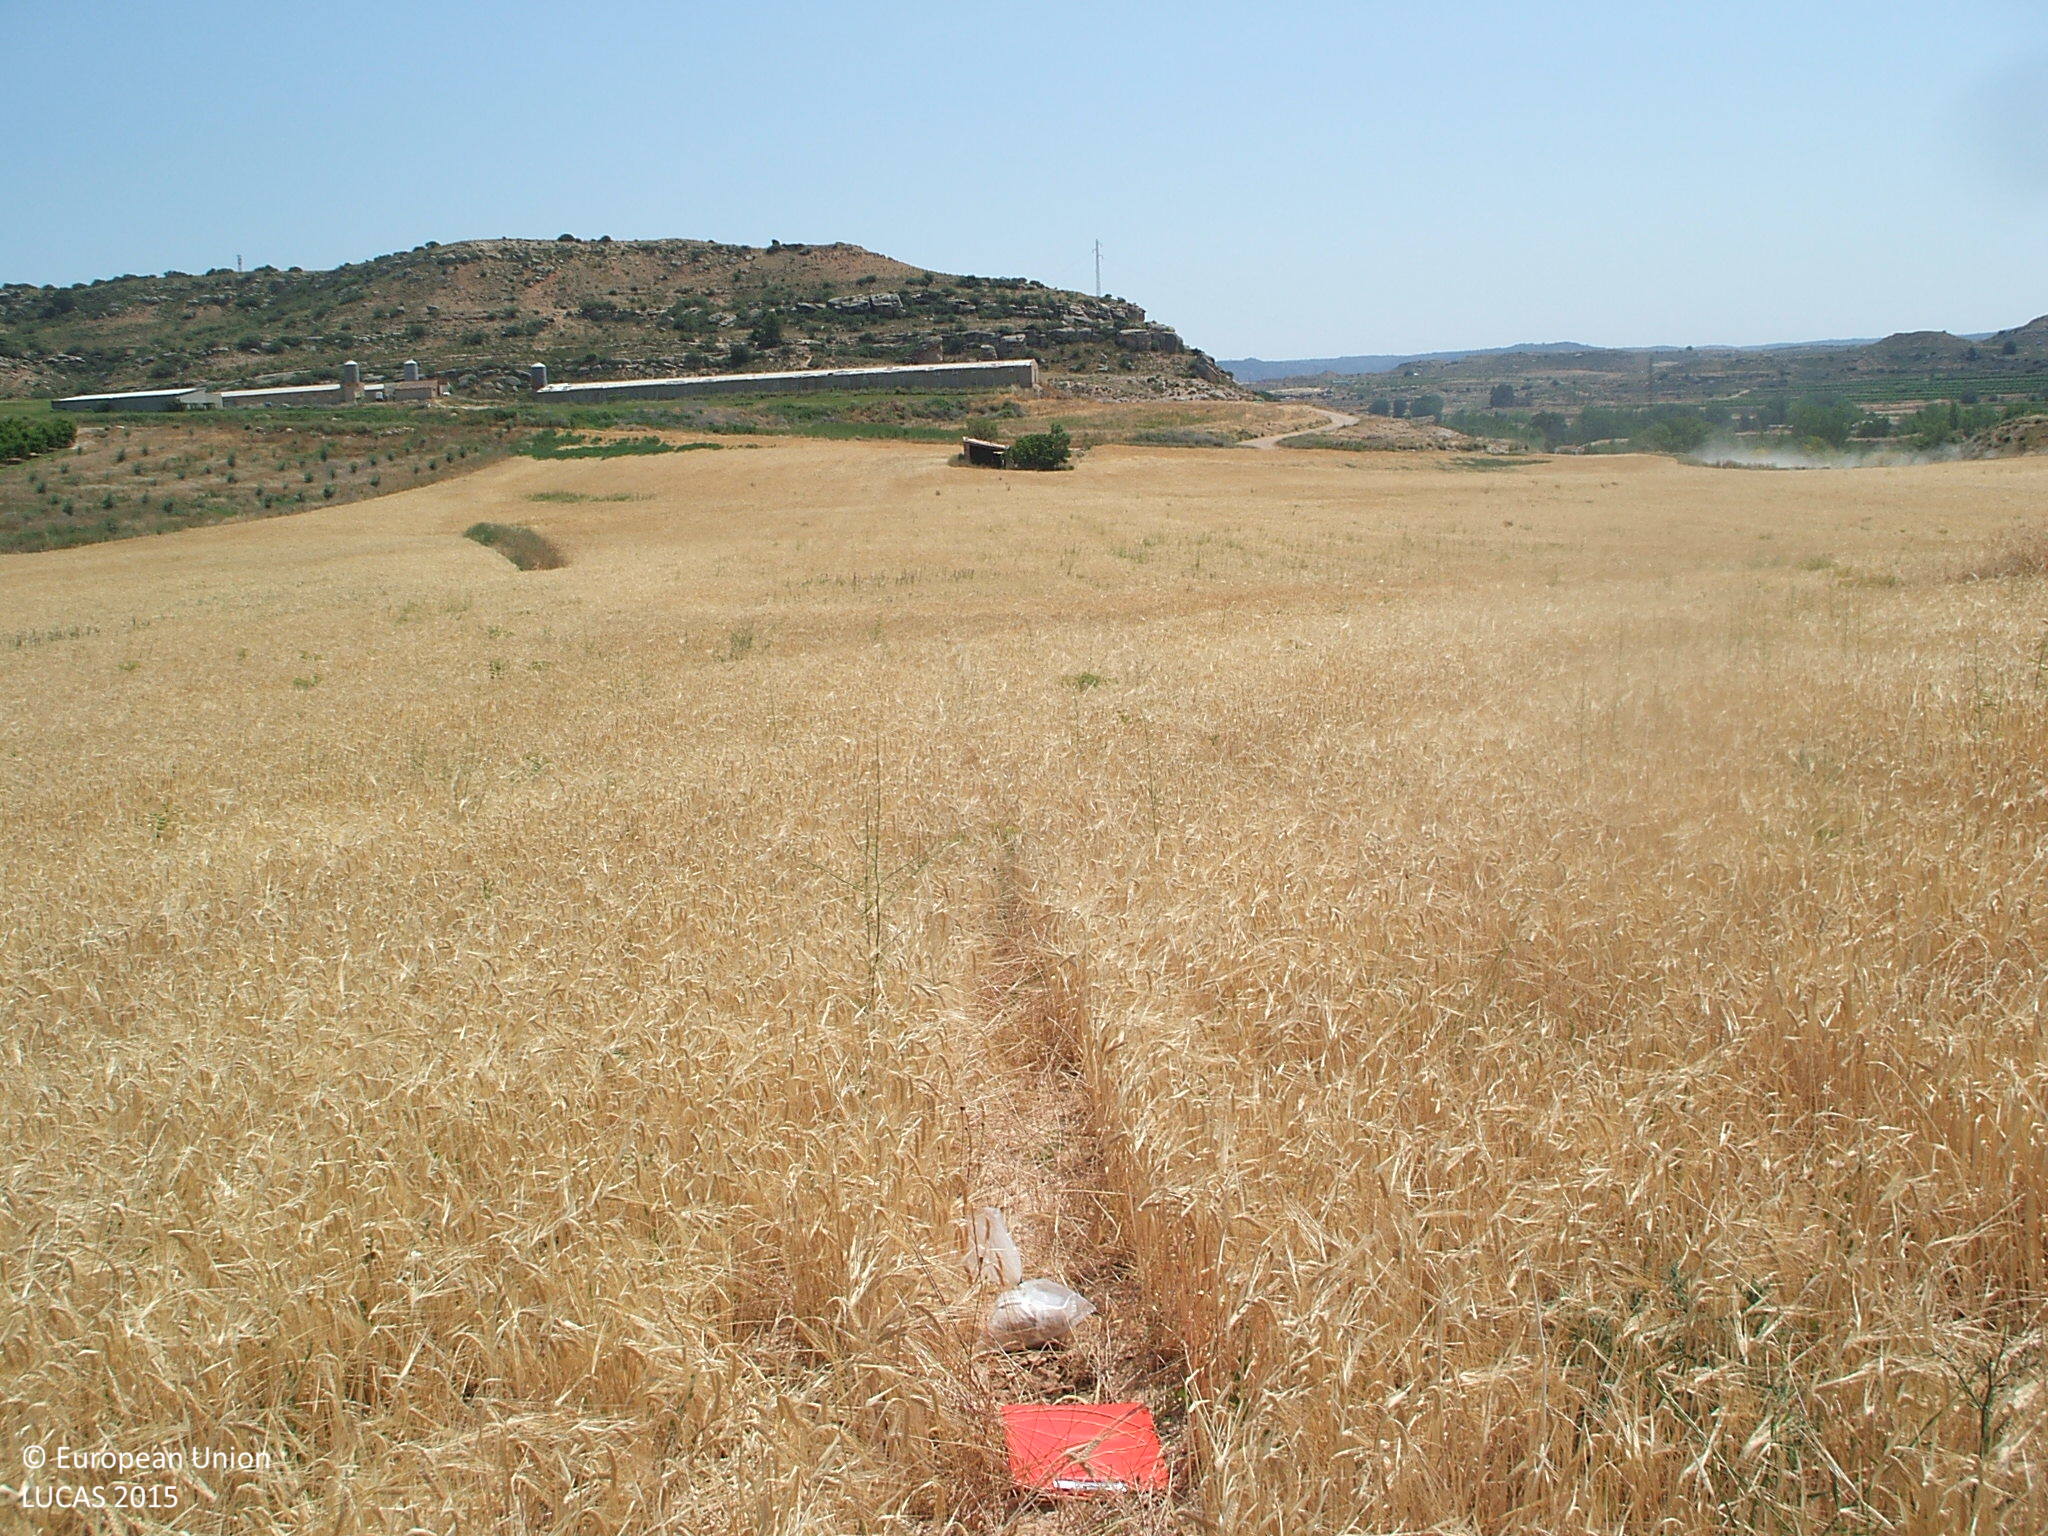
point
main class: Cropland
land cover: Barley
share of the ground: > 75 %
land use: Agriculture (excluding fallow land and kitchen gardens)
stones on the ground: > 50 %
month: June
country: ES
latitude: 40.9760
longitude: -0.1719
